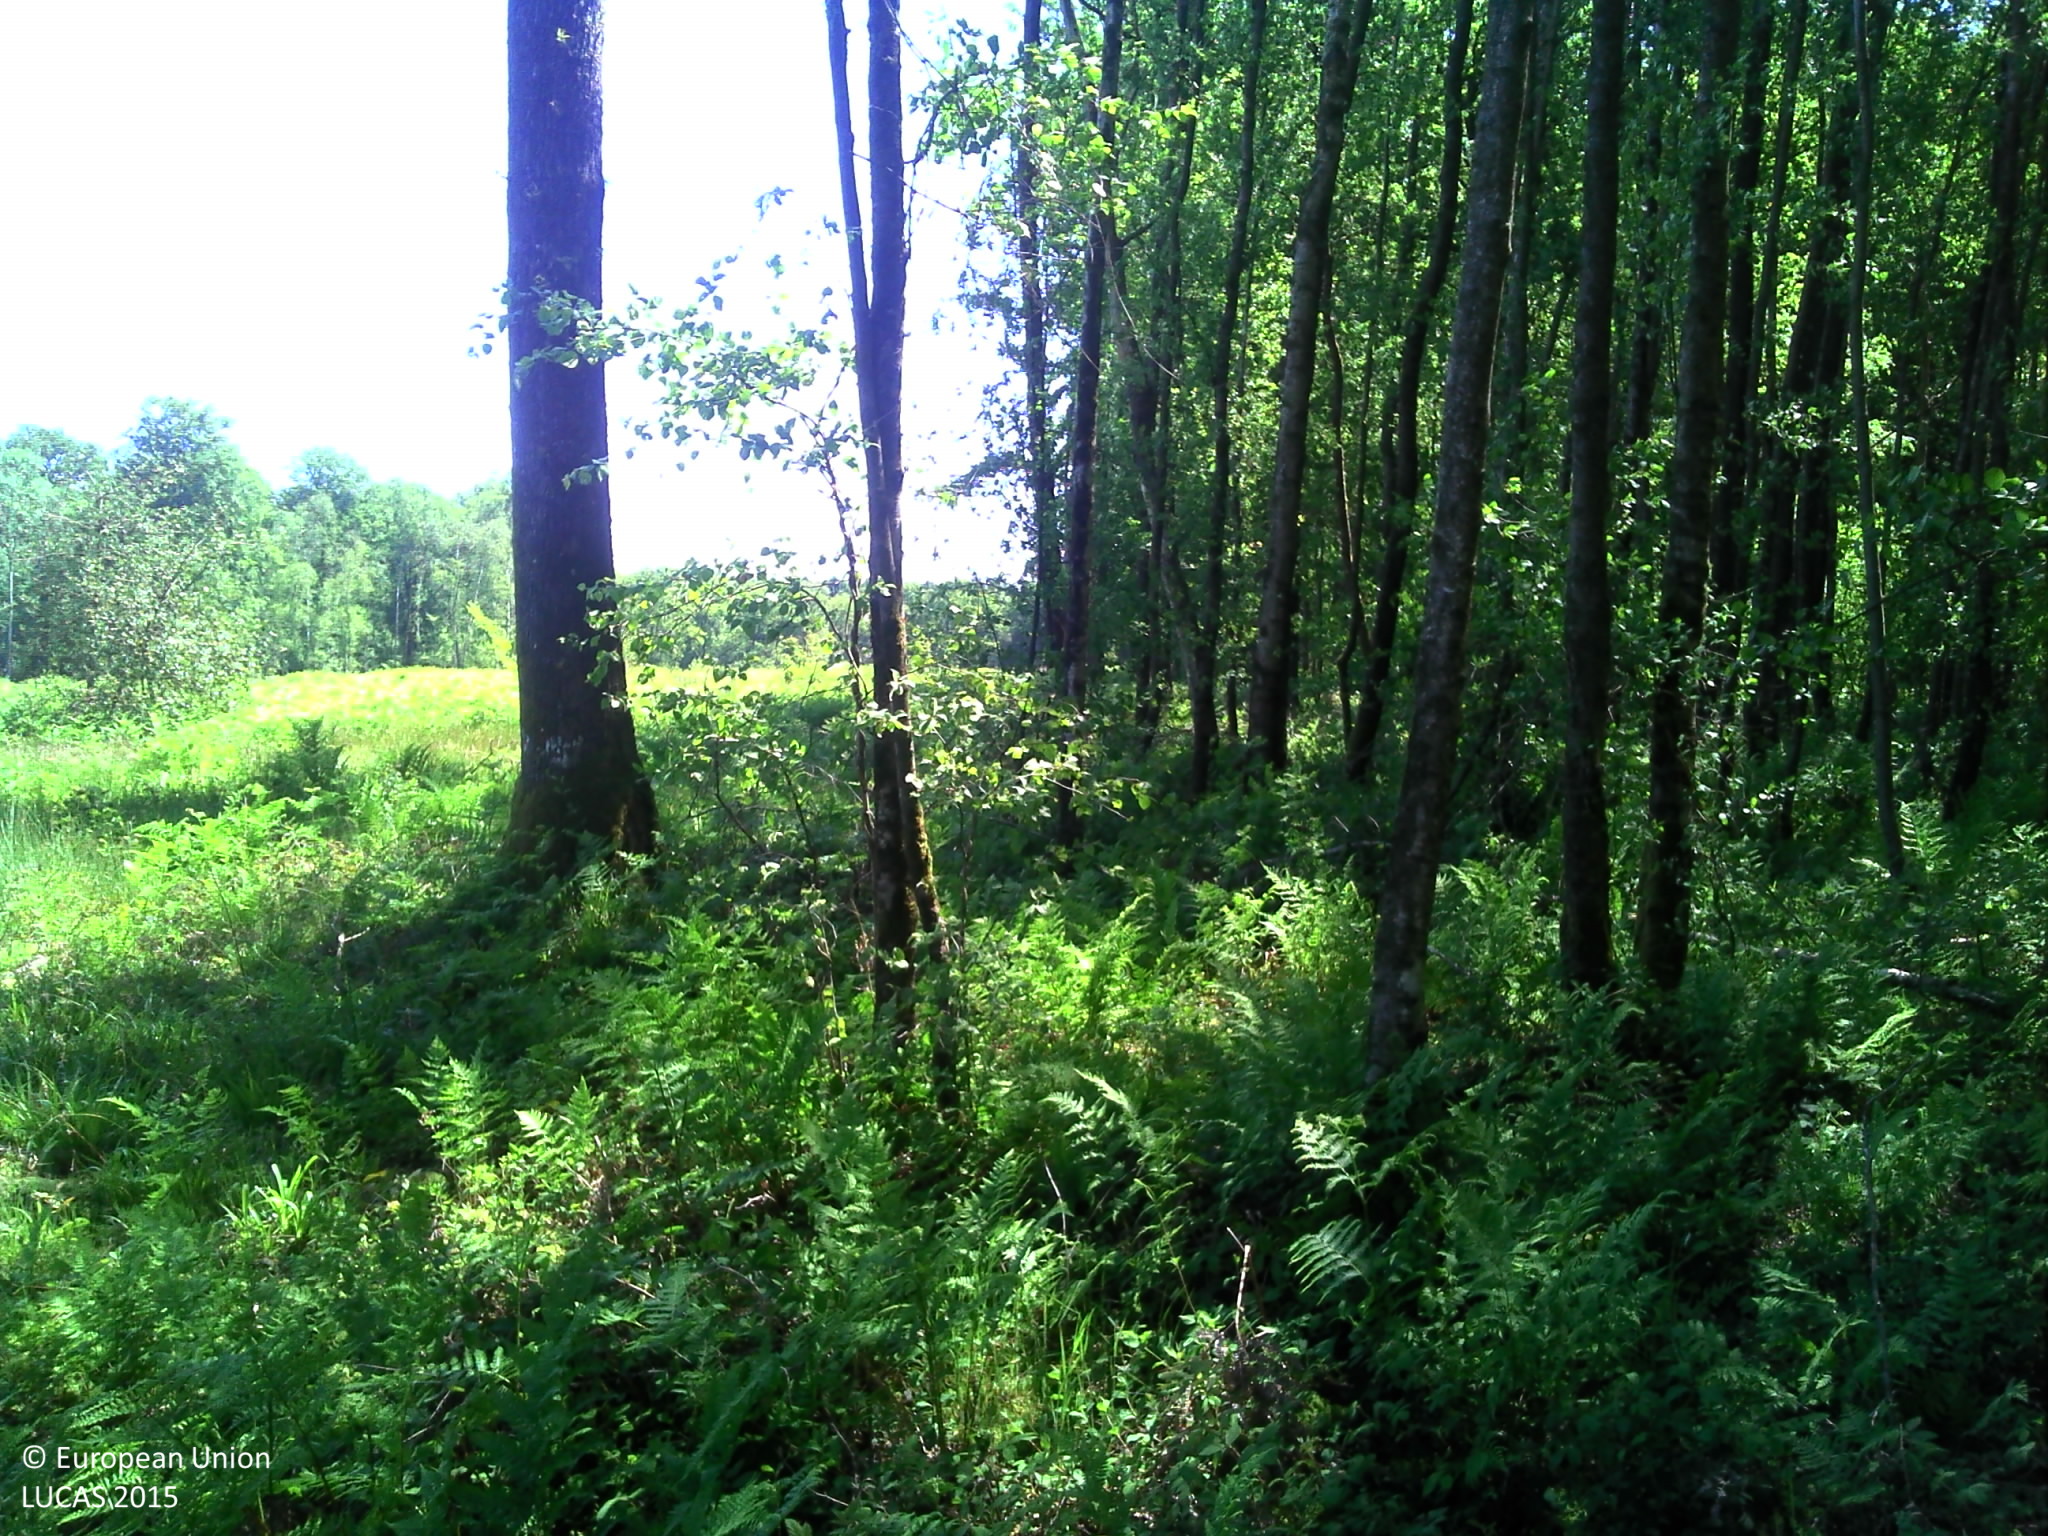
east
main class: Woodland
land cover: Broadleaved woodland
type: mesophytic deciduous forest
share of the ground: > 75 %
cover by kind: broadleaved forest trees 70 %, herbaceous plants 20 %, shrubs 10 %
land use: Forestry
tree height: > 5 m
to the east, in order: Broadleaved woodland; Tracks; Broadleaved woodland; Spontaneously vegetated surfaces
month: June
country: FR
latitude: 49.9471
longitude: 4.2118
